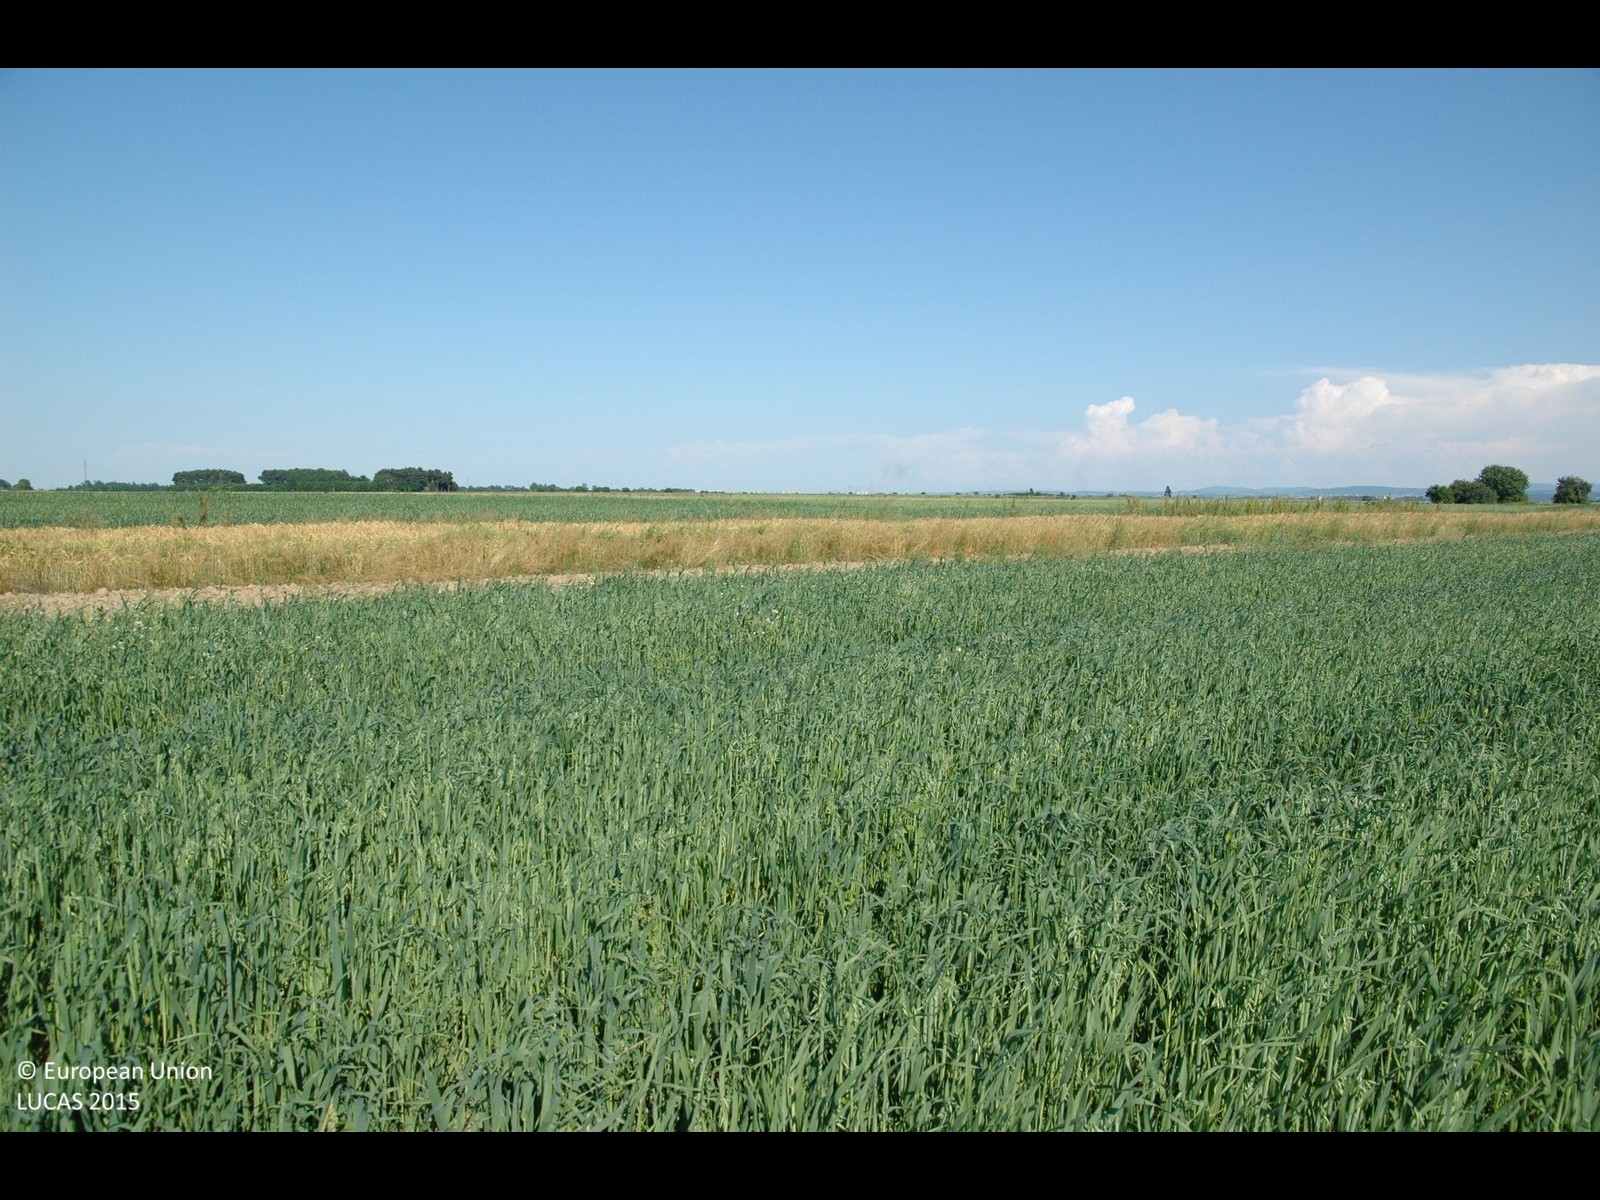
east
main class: Cropland
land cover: Oats
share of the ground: > 75 %
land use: Agriculture (excluding fallow land and kitchen gardens)
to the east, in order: Oats; Spontaneously vegetated surfaces; Oats; Maize; Common wheat; Oats; Triticale; Barley; Oats; Barley; Oats
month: June
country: HR
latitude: 46.3162
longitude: 16.1944
